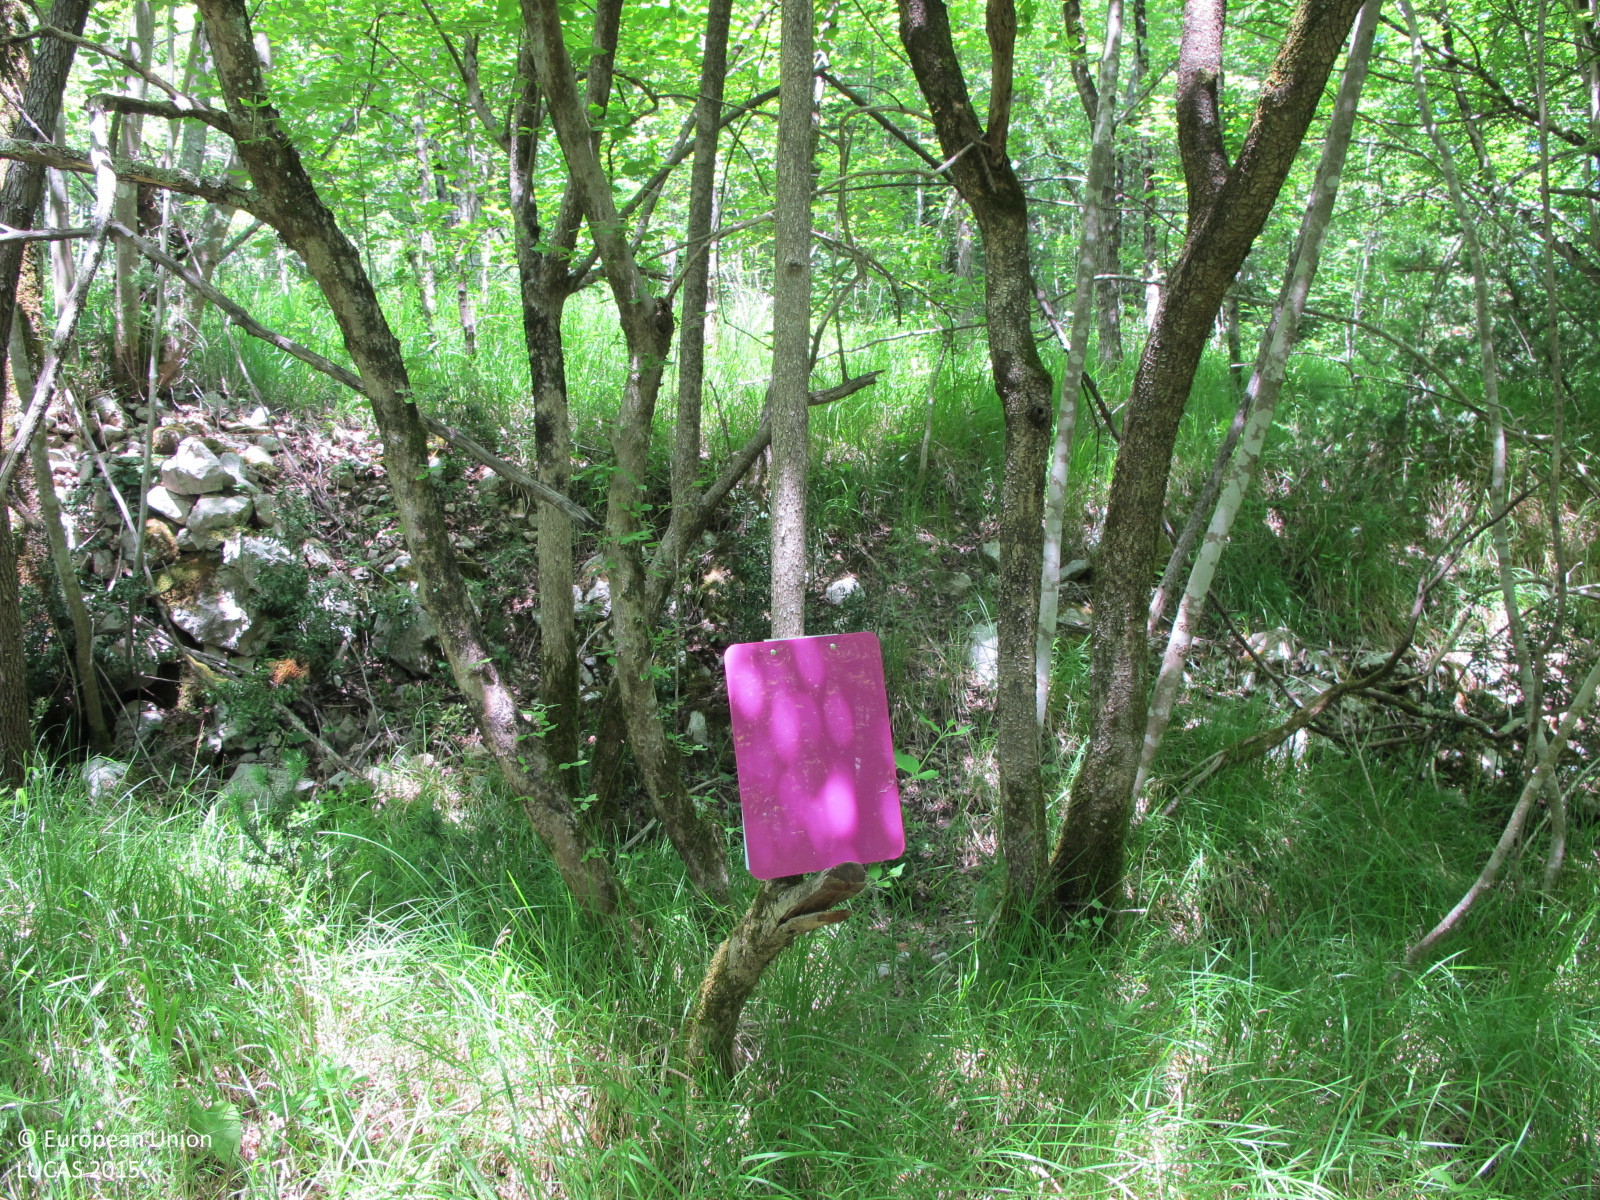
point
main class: Woodland
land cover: Broadleaved woodland
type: thermophilous deciduous forest
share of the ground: > 75 %
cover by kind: broadleaved forest trees 75 %, shrubs 10 %, herbaceous plants 10 %, consolidated bare surface 5 %
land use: Forestry
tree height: > 5 m
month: May
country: HR
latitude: 45.1850
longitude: 14.2327
